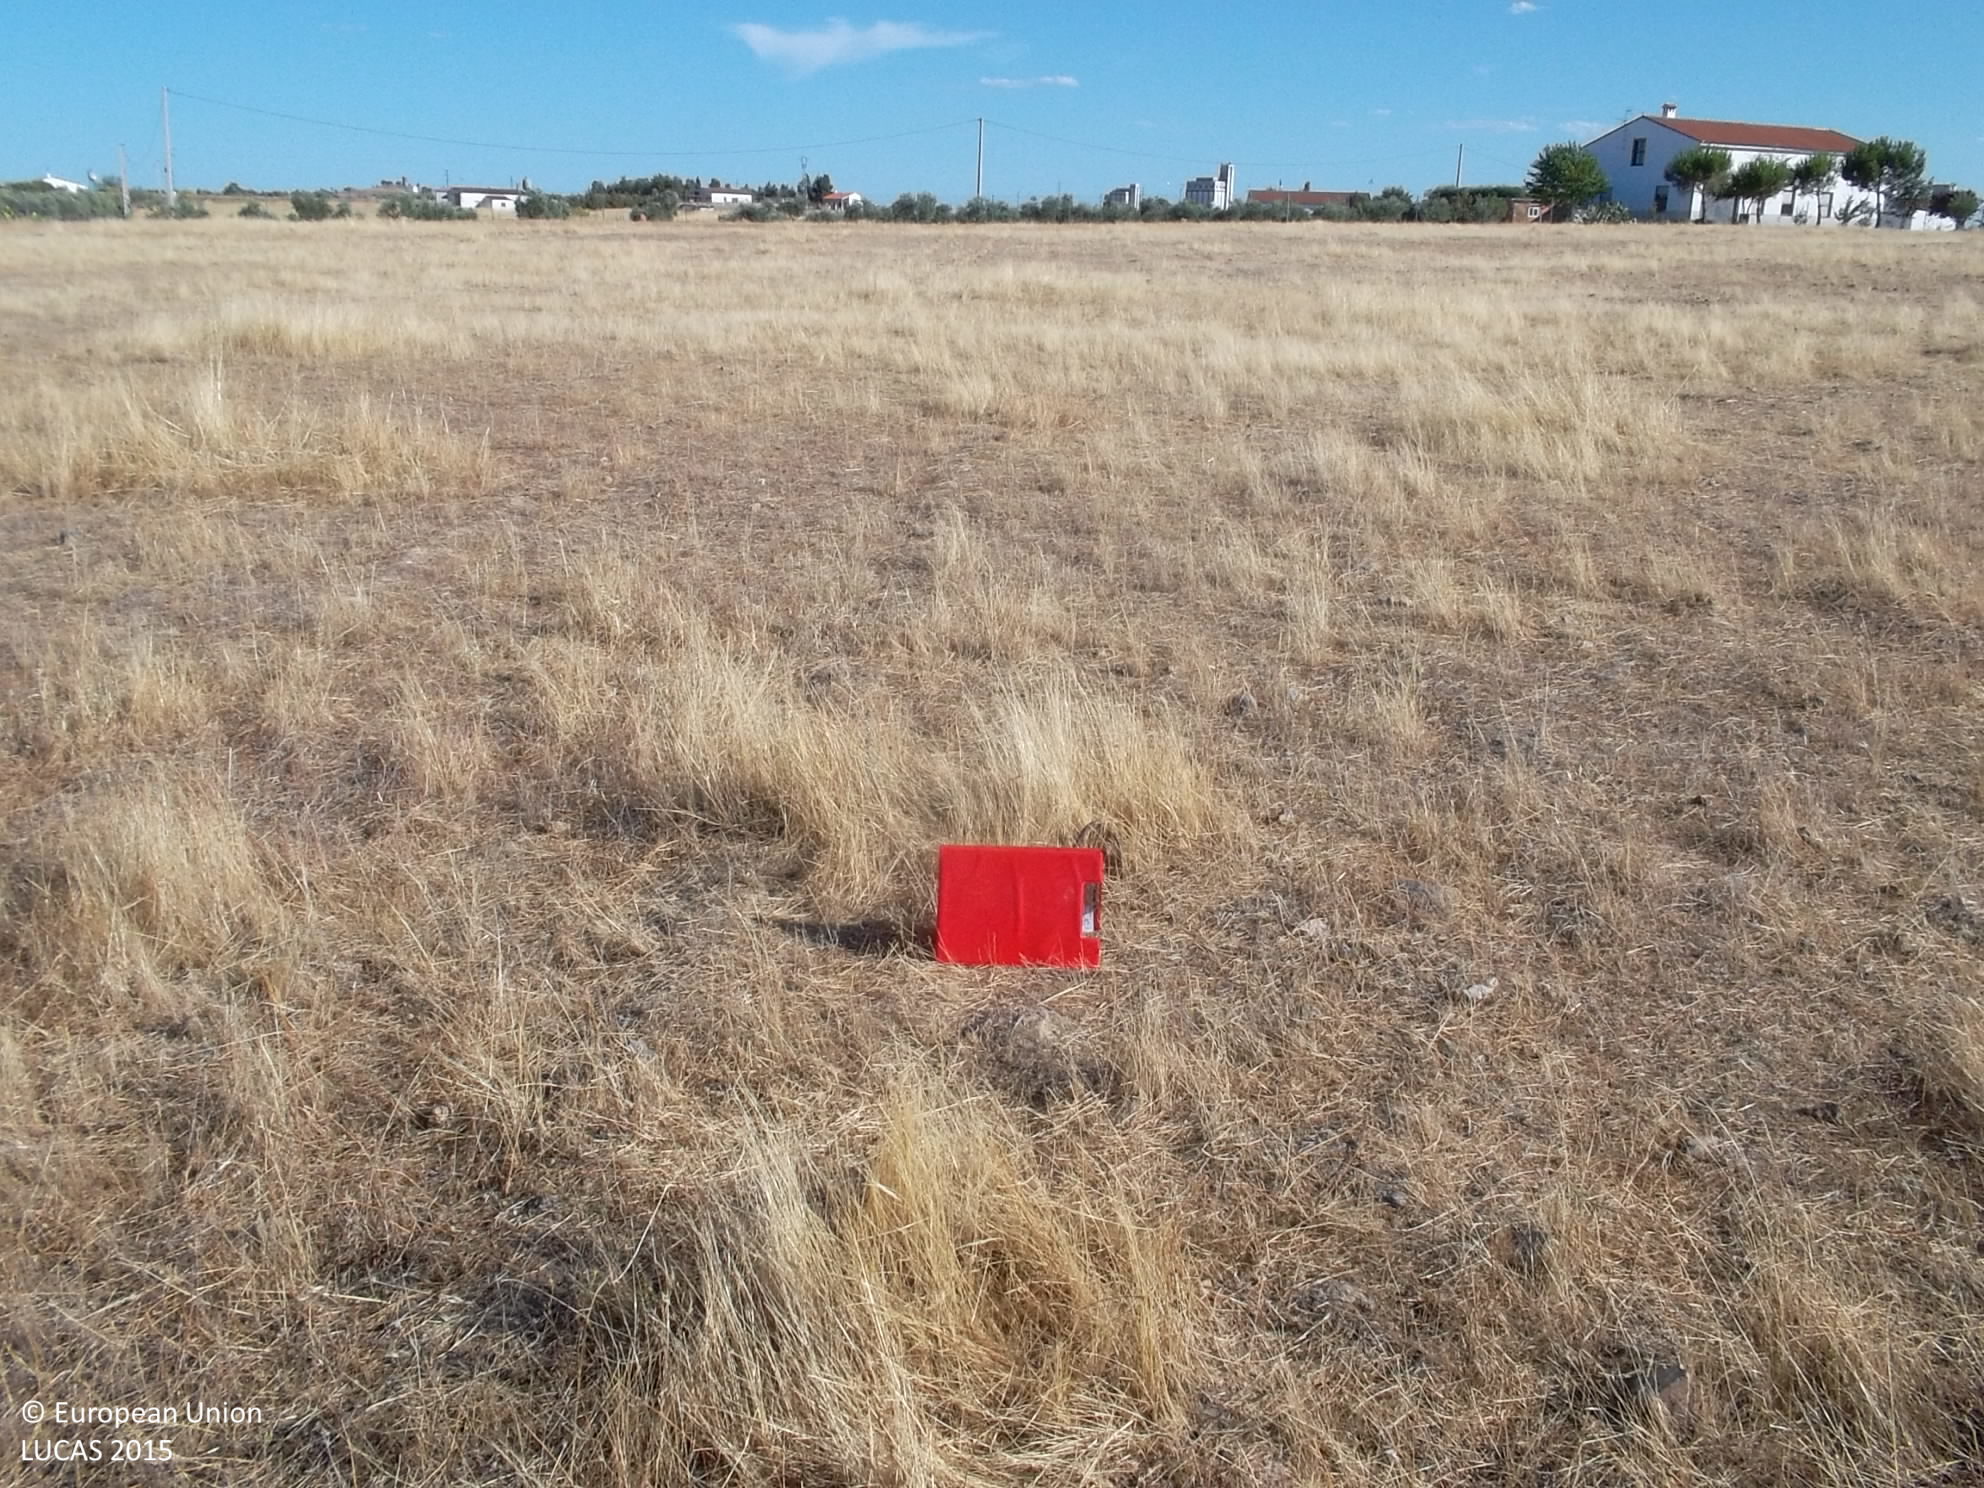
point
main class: Grassland
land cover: Spontaneously vegetated surfaces
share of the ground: > 75 %
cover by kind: herbaceous plants 100 %
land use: Agriculture (excluding fallow land and kitchen gardens)
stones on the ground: 10 - 25 %
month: July
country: ES
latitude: 38.2793
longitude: -5.6845
